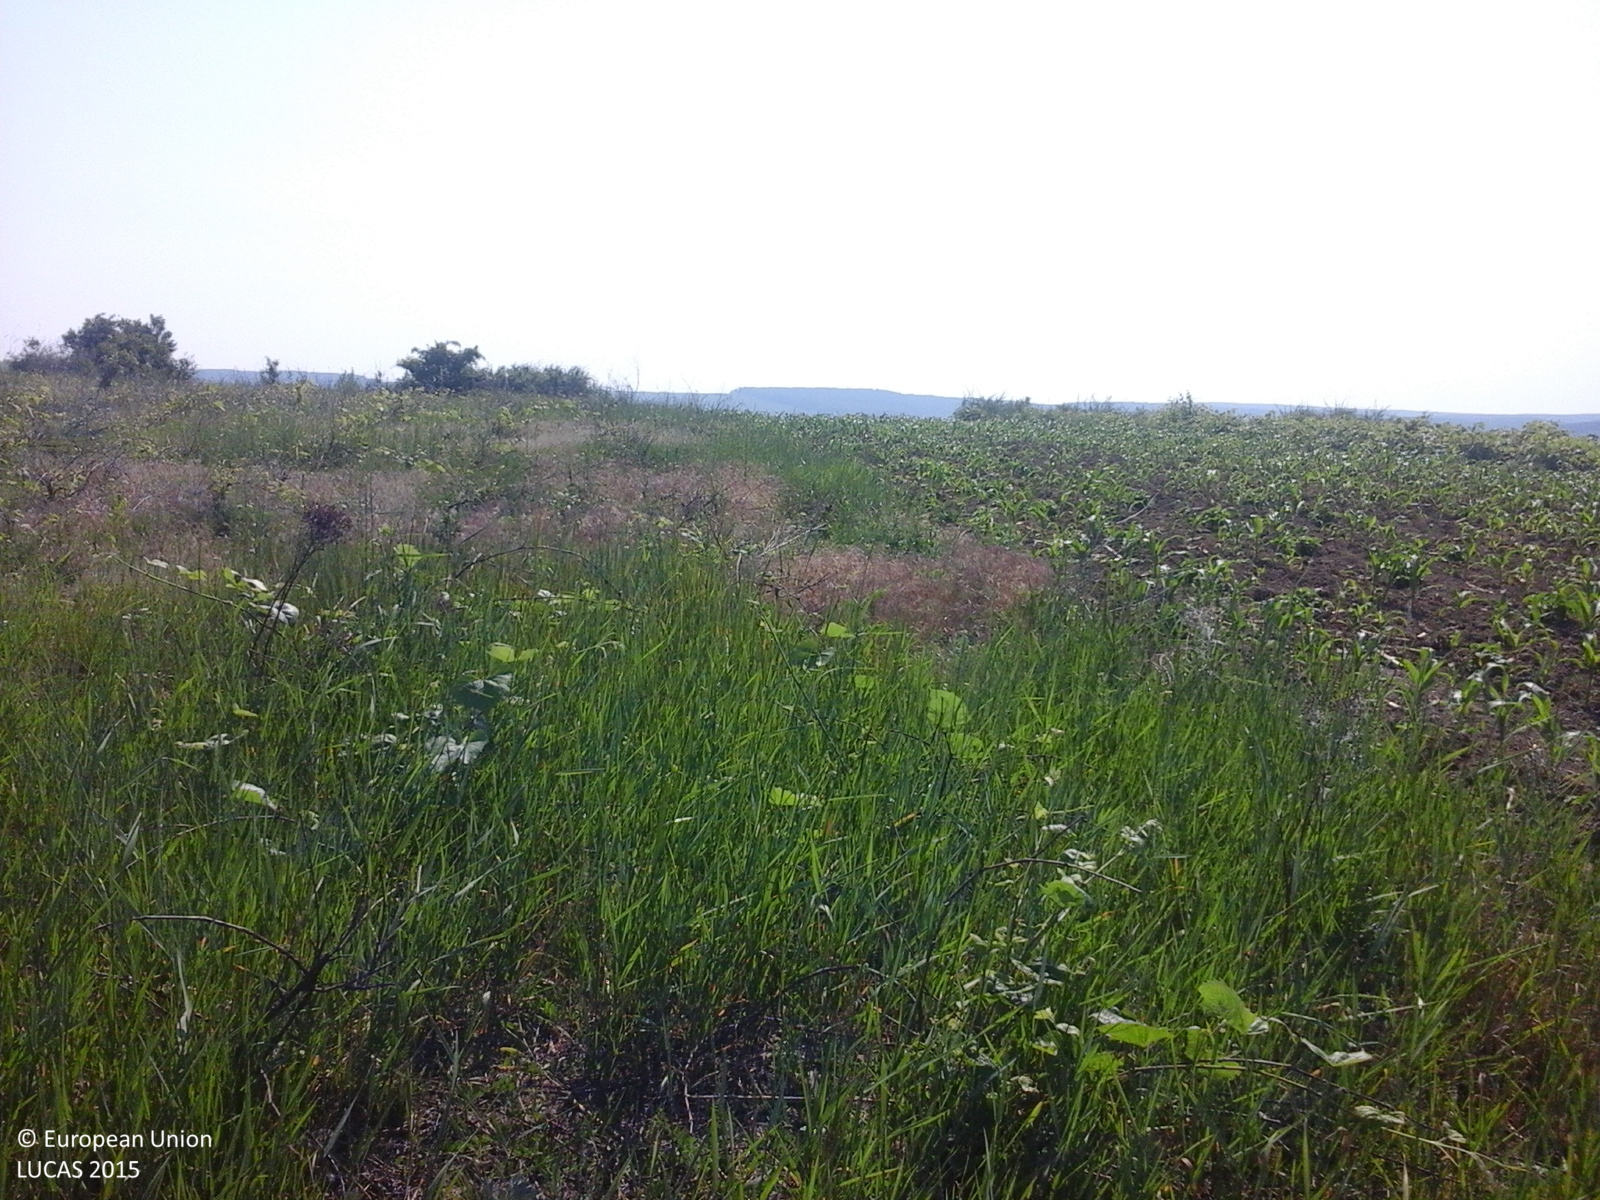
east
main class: Cropland
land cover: Vineyards
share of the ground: 10 - 25 %
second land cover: Grassland without tree/shrub cover
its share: 50 - 75 %
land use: Agriculture (excluding fallow land and kitchen gardens)
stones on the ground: < 10 %
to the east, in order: Vineyards; Grassland without tree/shrub cover; Abandoned hedges; Tracks; Maize; Lucerne; Other bare soil; Spontaneously vegetated surfaces; Maize; Common wheat; Grassland without tree/shrub cover; Maize; Other bare soil; Lucerne; Maize; Other bare soil; Grassland without tree/shrub cover
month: June
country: RO
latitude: 46.3399
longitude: 27.1045
